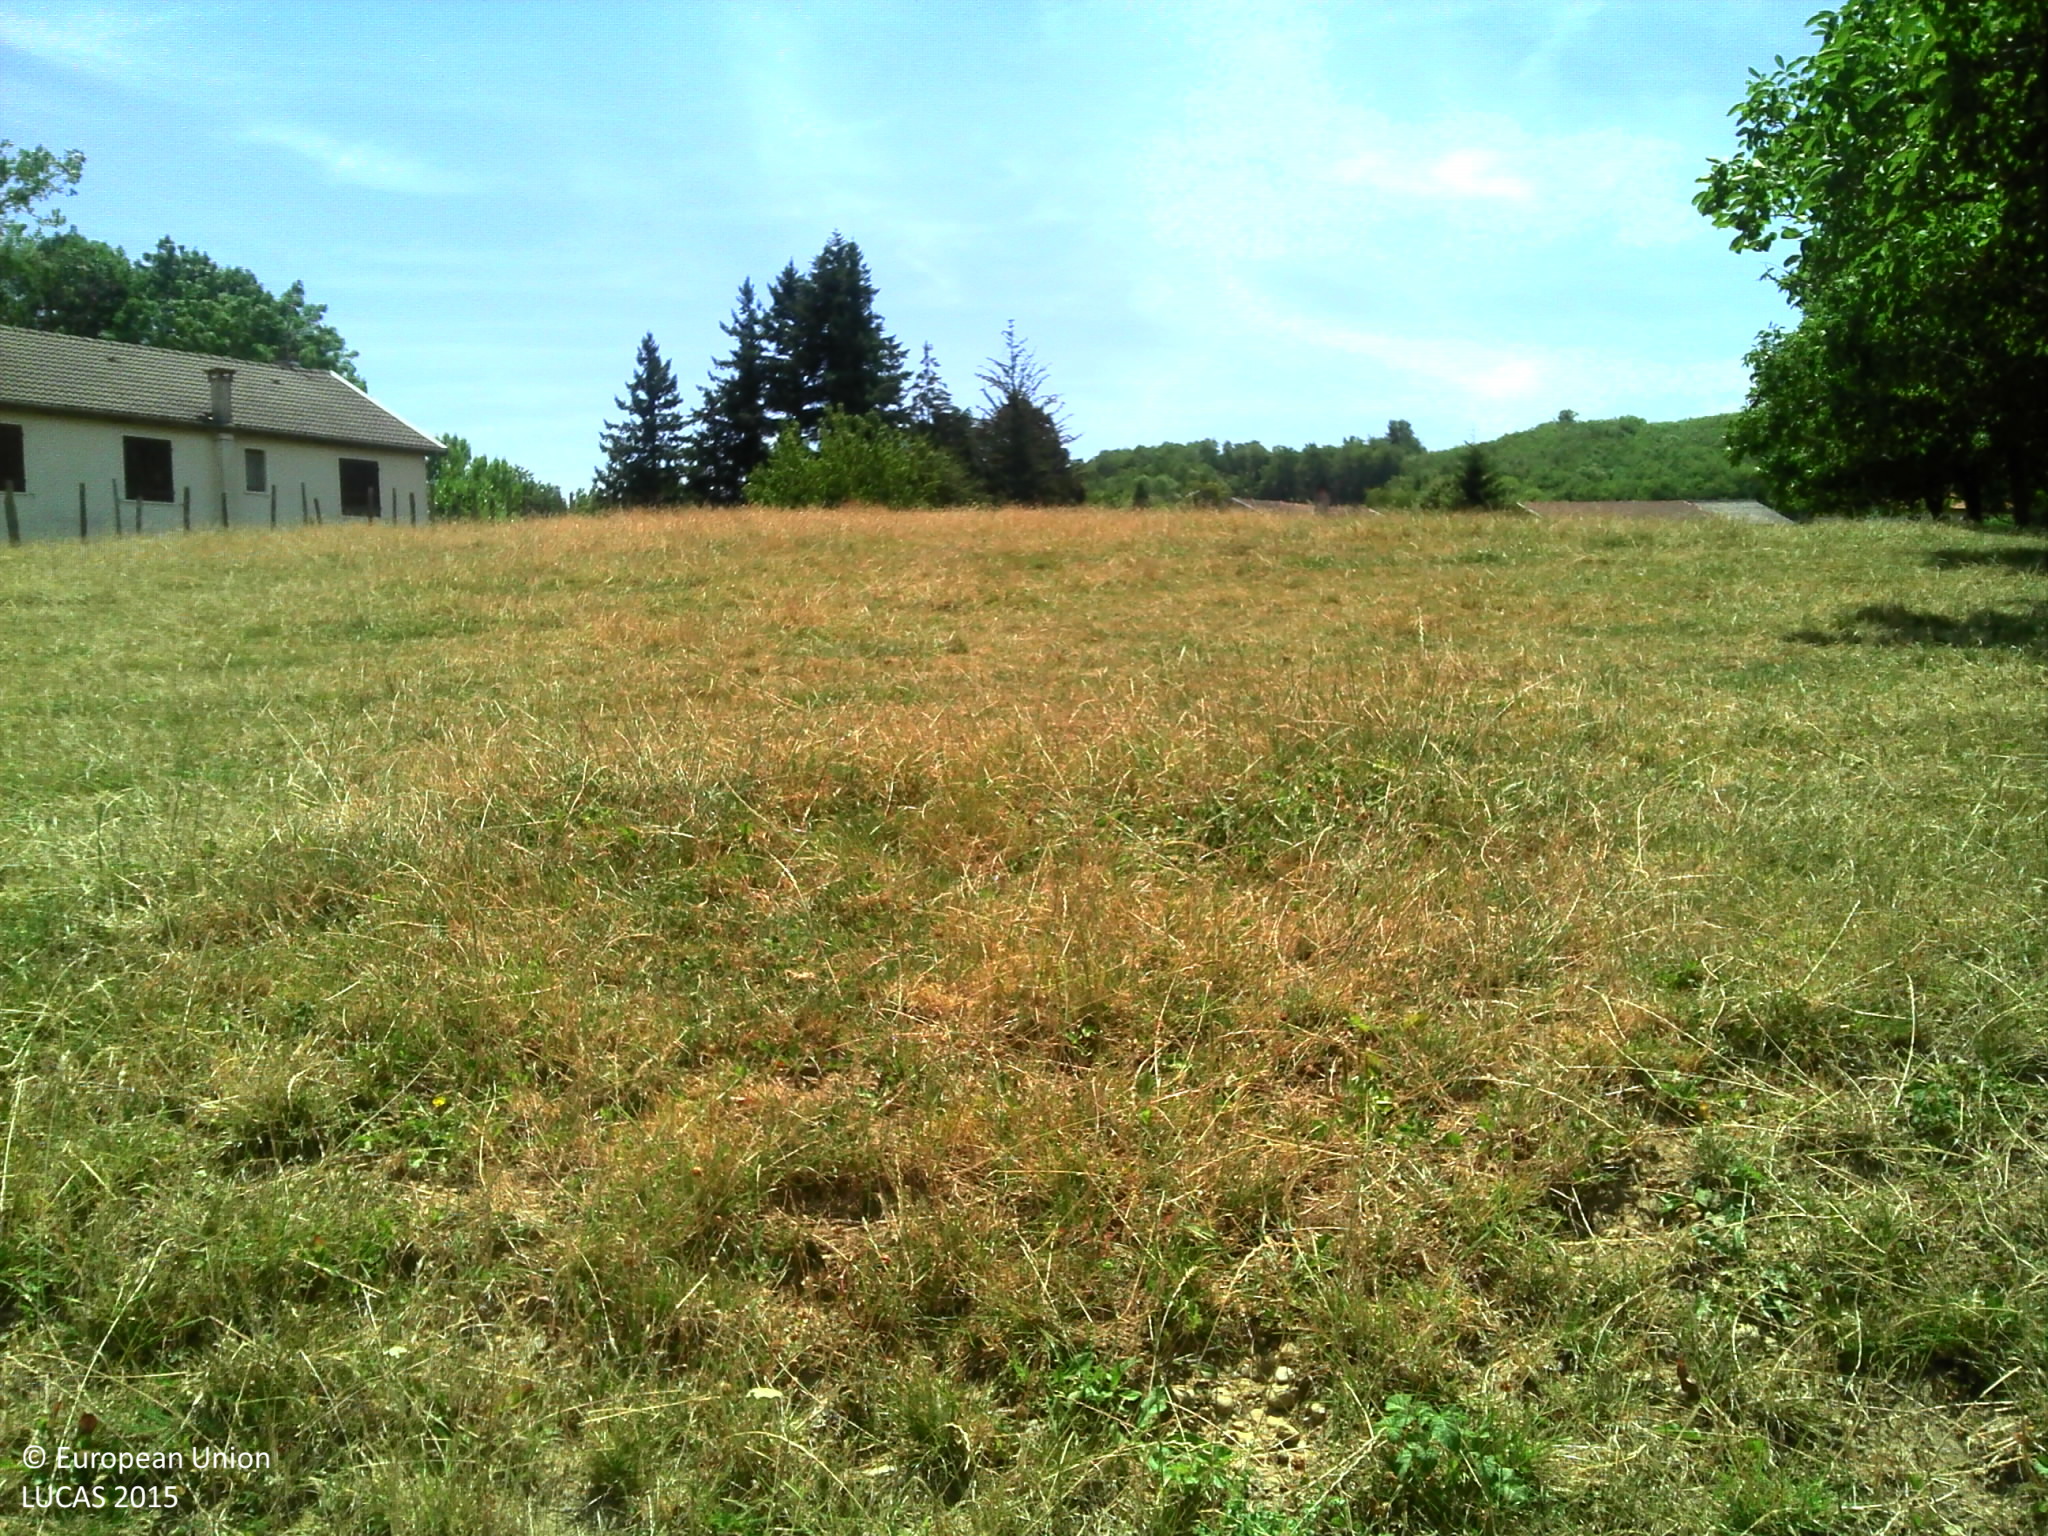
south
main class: Grassland
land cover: Grassland with sparse tree/shrub cover
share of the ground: > 75 %
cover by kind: herbaceous plants 90 %, broadleaved forest trees 5 %, consolidated bare surface 5 %
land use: Agriculture (excluding fallow land and kitchen gardens)
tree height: > 5 m
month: July
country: FR
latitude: 45.3049
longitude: 5.1968
